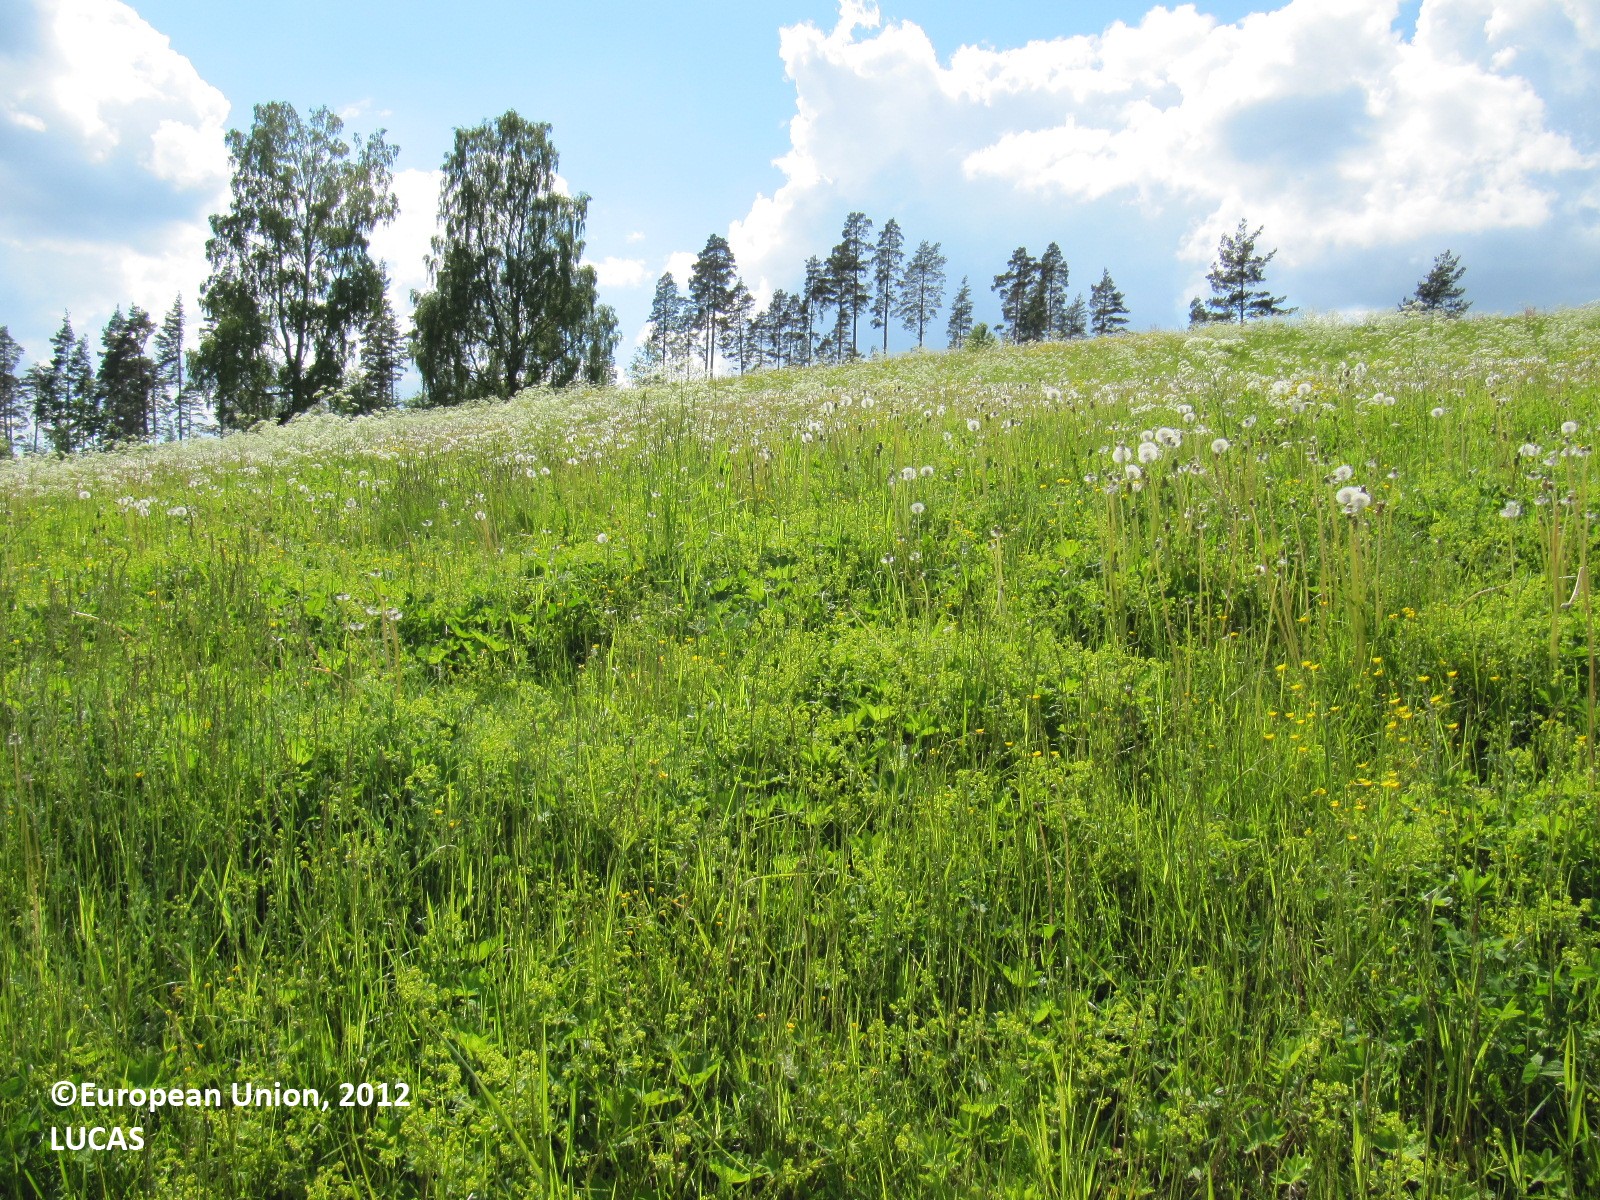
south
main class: Cropland
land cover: Rye
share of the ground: > 75 %
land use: Agriculture (excluding fallow land and kitchen gardens)
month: June
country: FI
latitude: 60.2941
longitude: 23.8990
